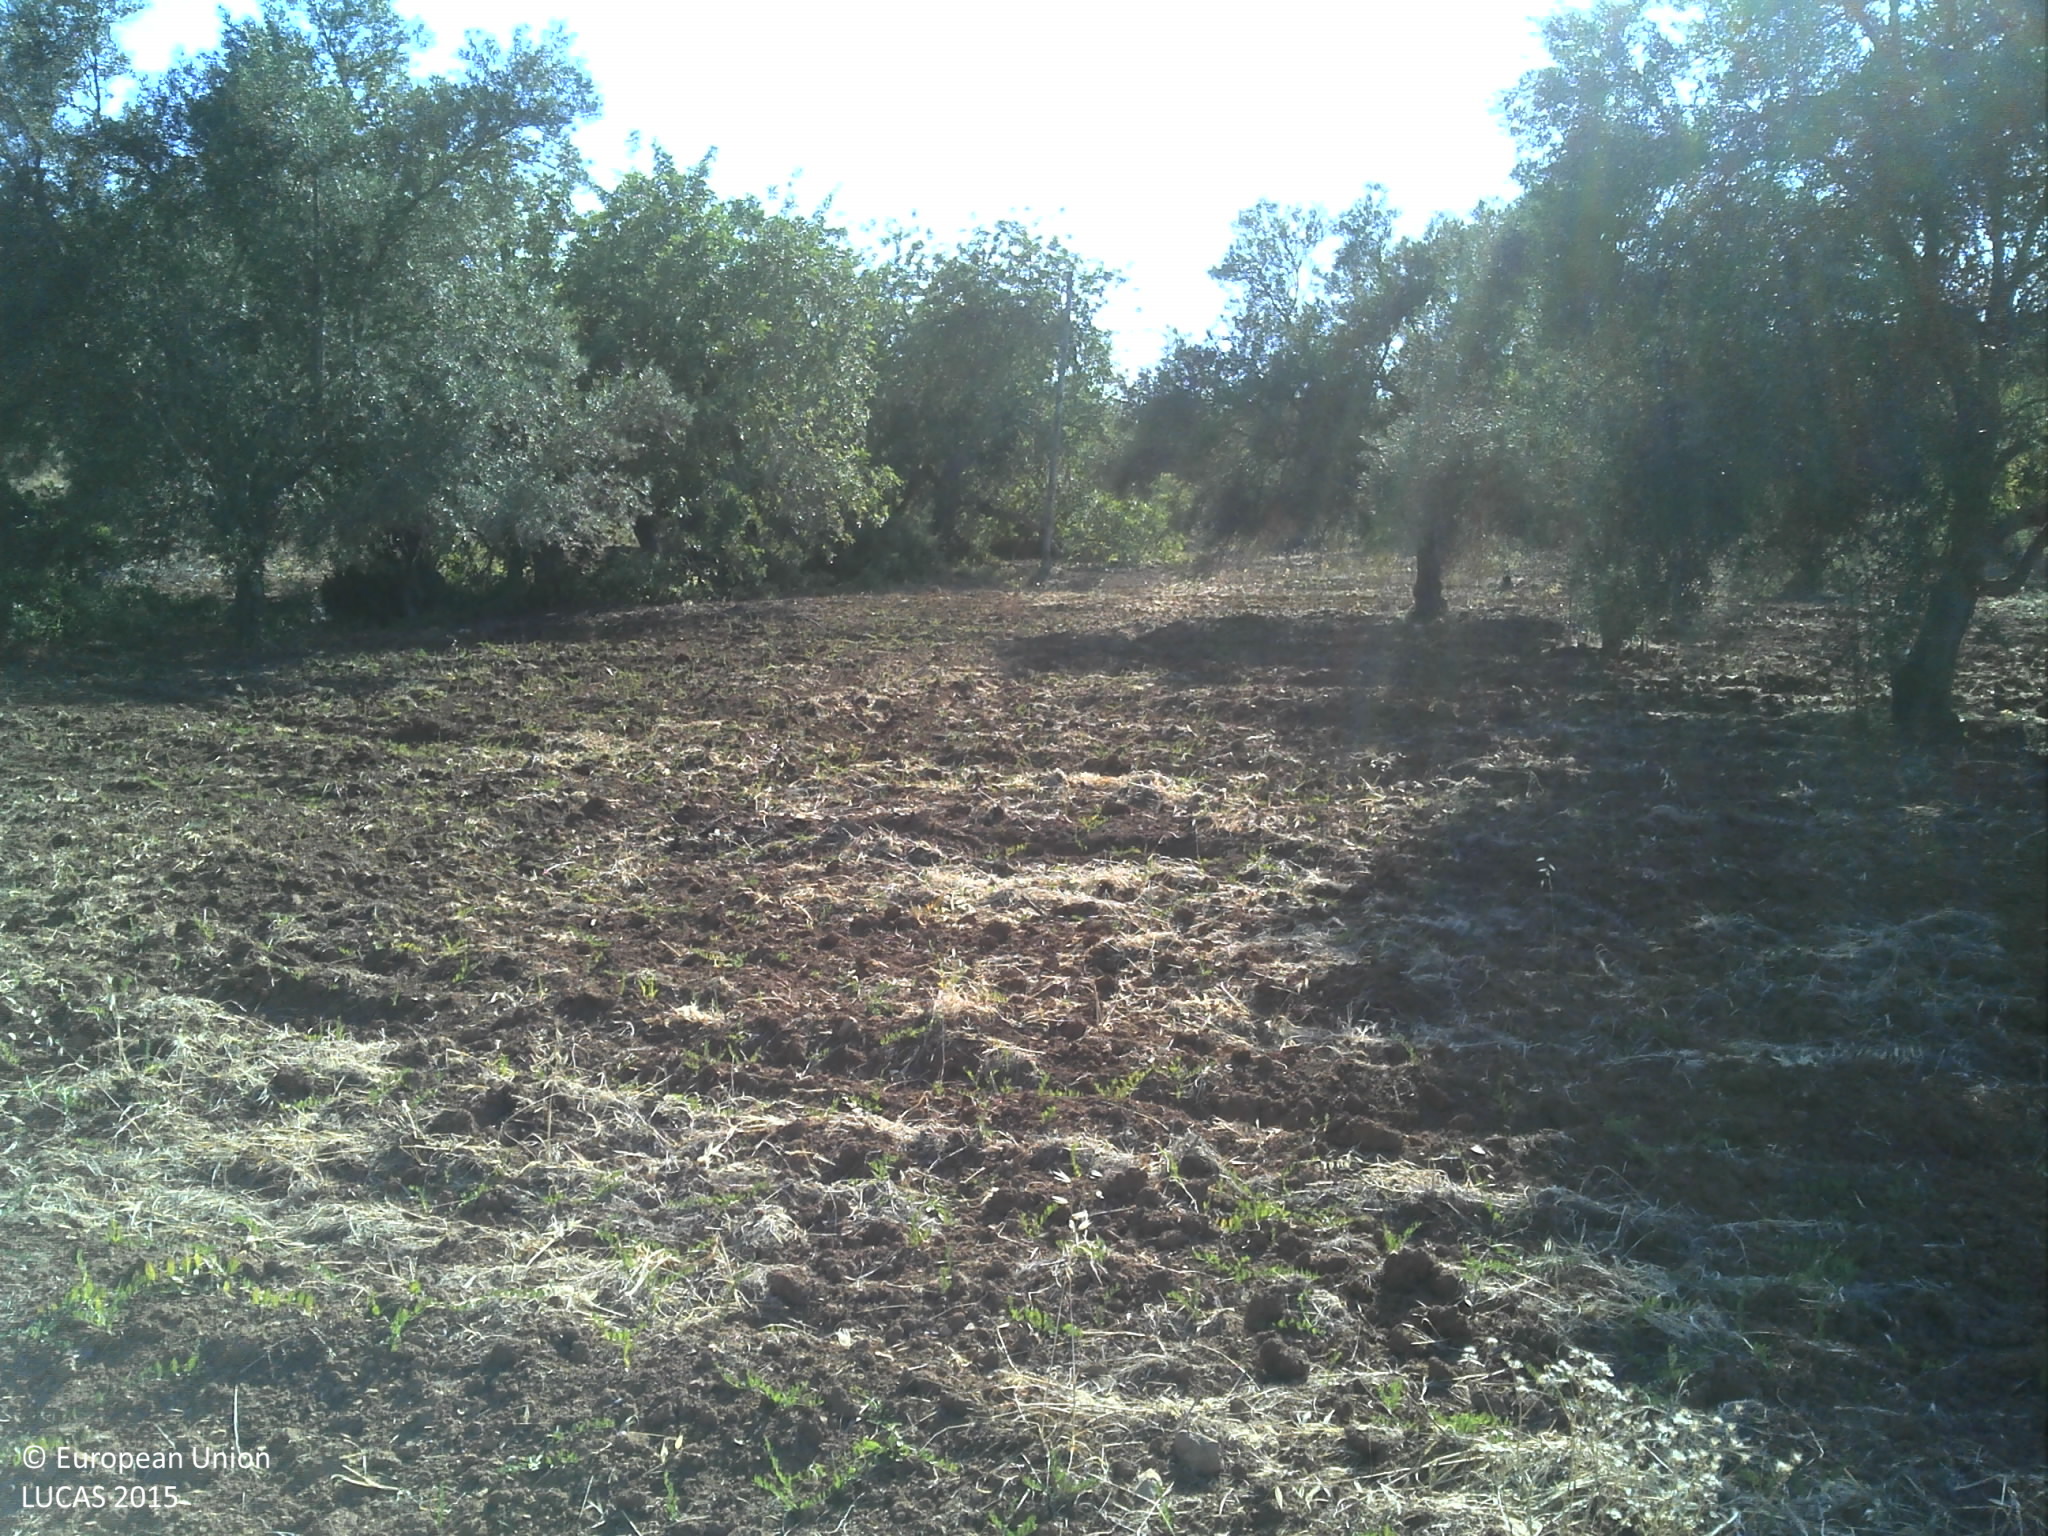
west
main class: Cropland
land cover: Permanent industrial crops
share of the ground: < 10 %
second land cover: Other bare soil
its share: > 75 %
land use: Agriculture (excluding fallow land and kitchen gardens)
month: June
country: PT
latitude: 37.0996
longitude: -7.7503
